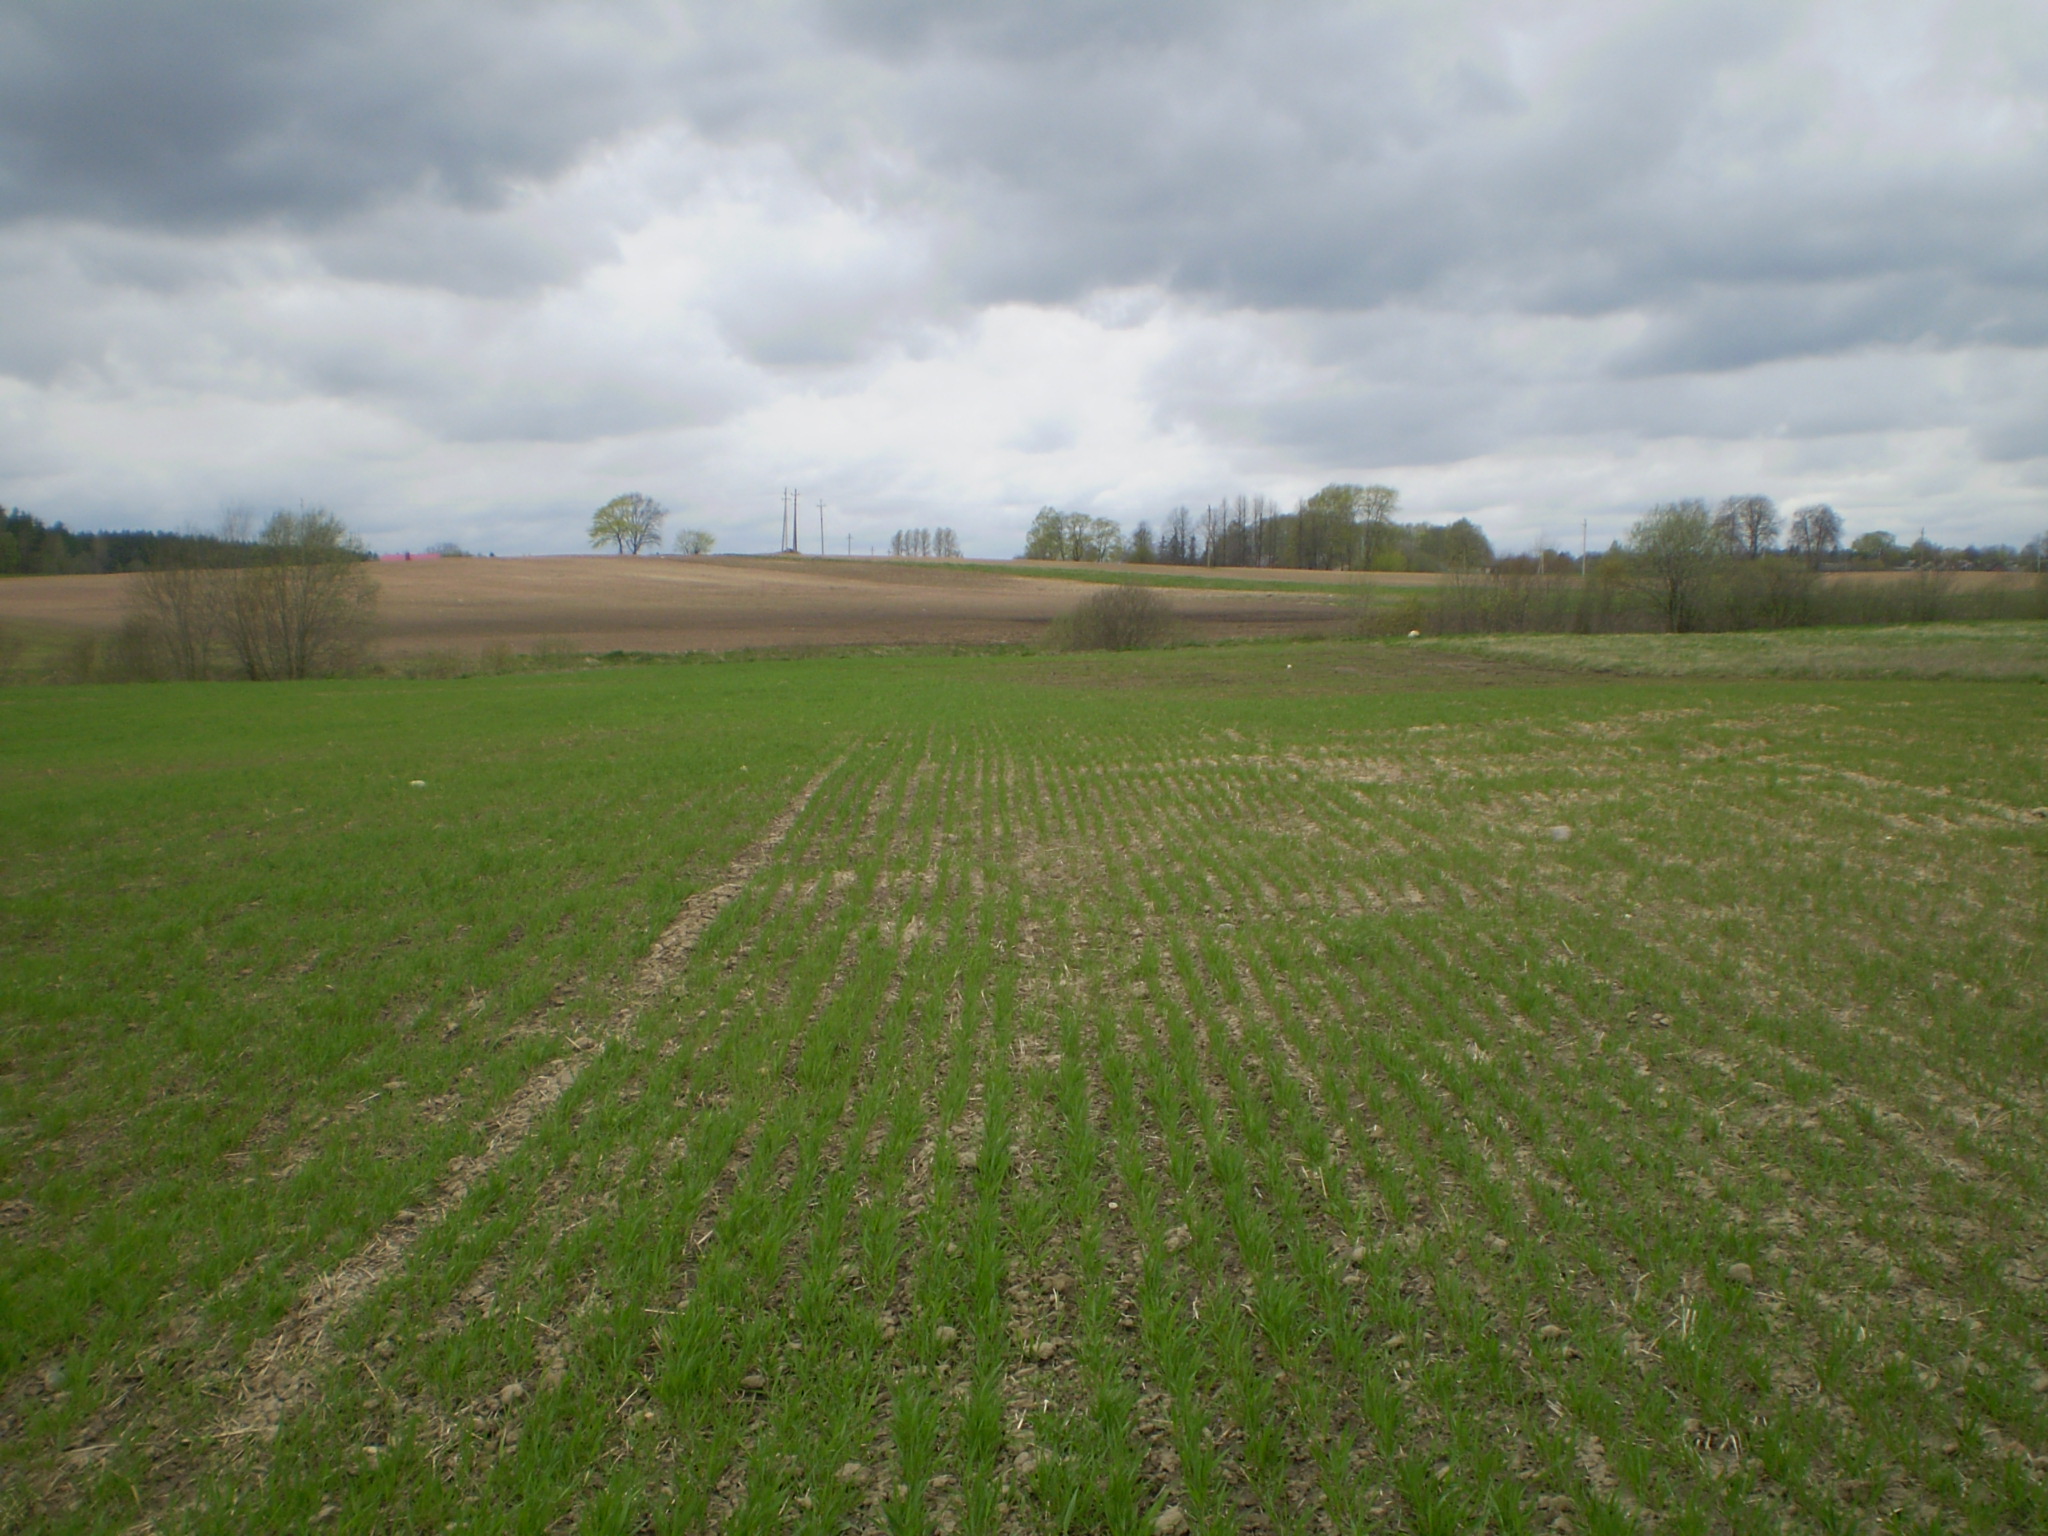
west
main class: Cropland
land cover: Common wheat
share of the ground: 50 - 75 %
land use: Agriculture (excluding fallow land and kitchen gardens)
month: May
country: LT
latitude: 56.4112
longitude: 22.1262
